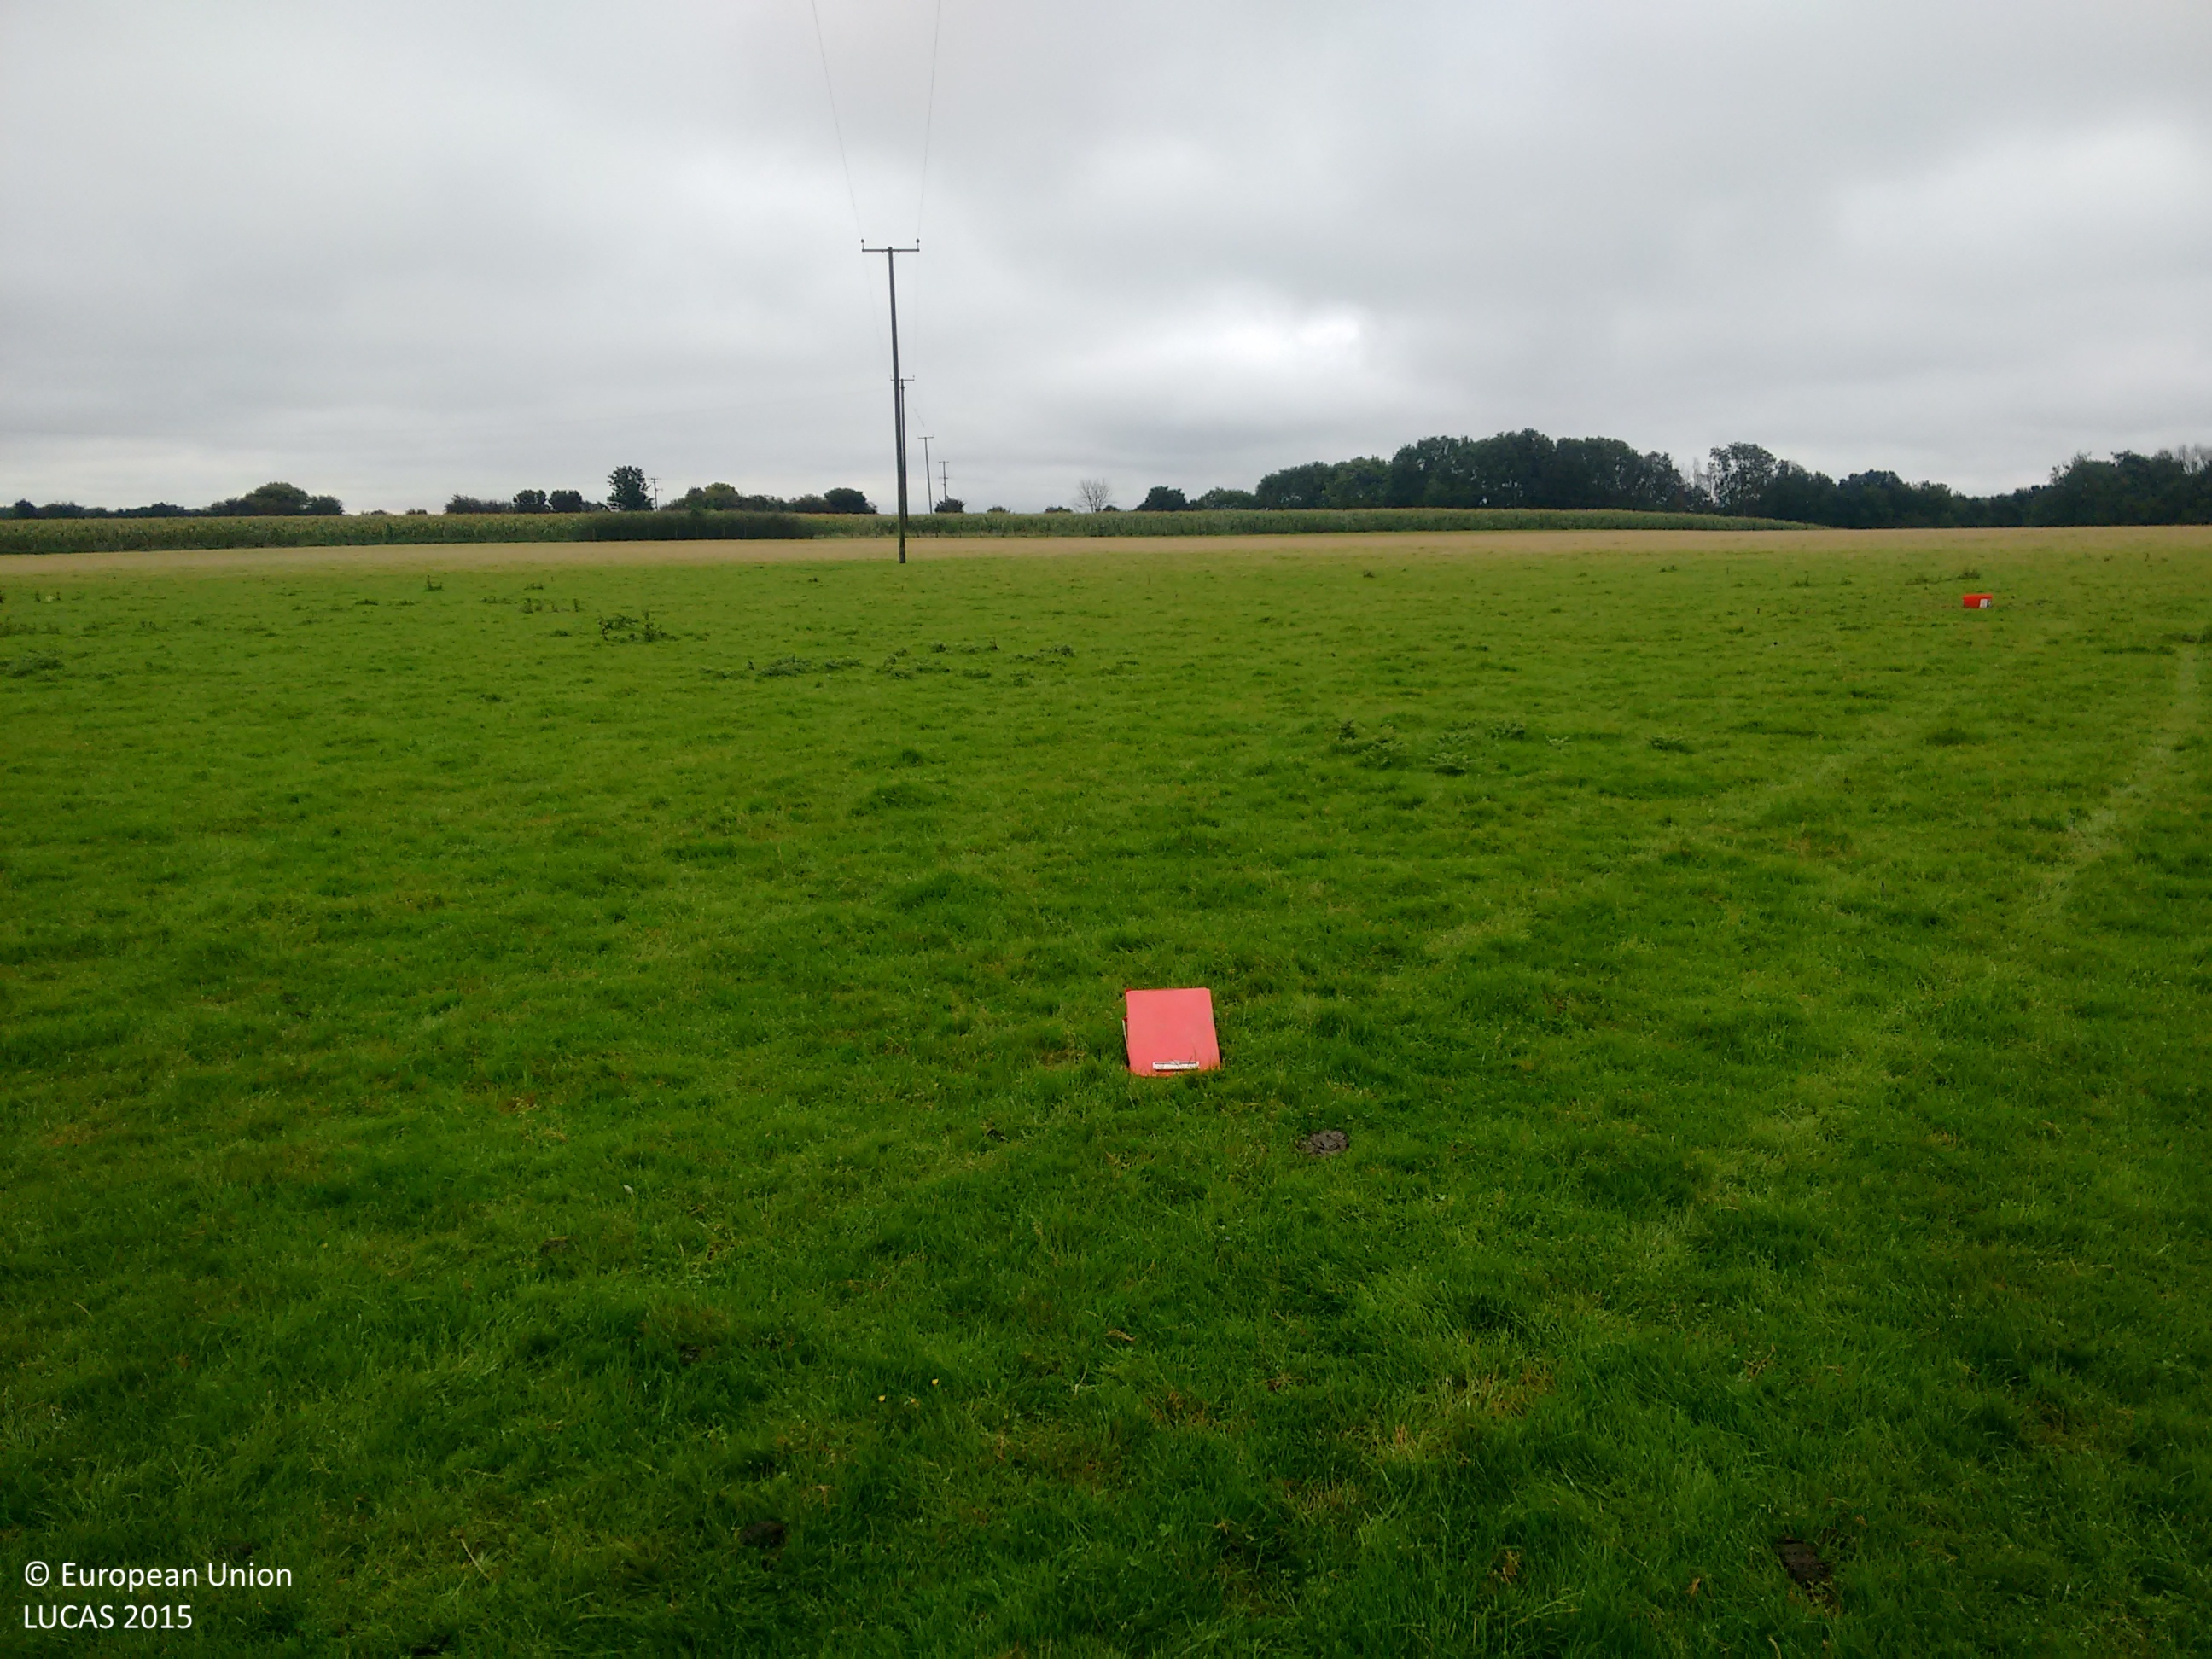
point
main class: Grassland
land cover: Grassland without tree/shrub cover
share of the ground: > 75 %
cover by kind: herbaceous plants 100 %
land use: Agriculture (excluding fallow land and kitchen gardens)
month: October
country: GB
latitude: 51.3185
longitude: 0.6325
